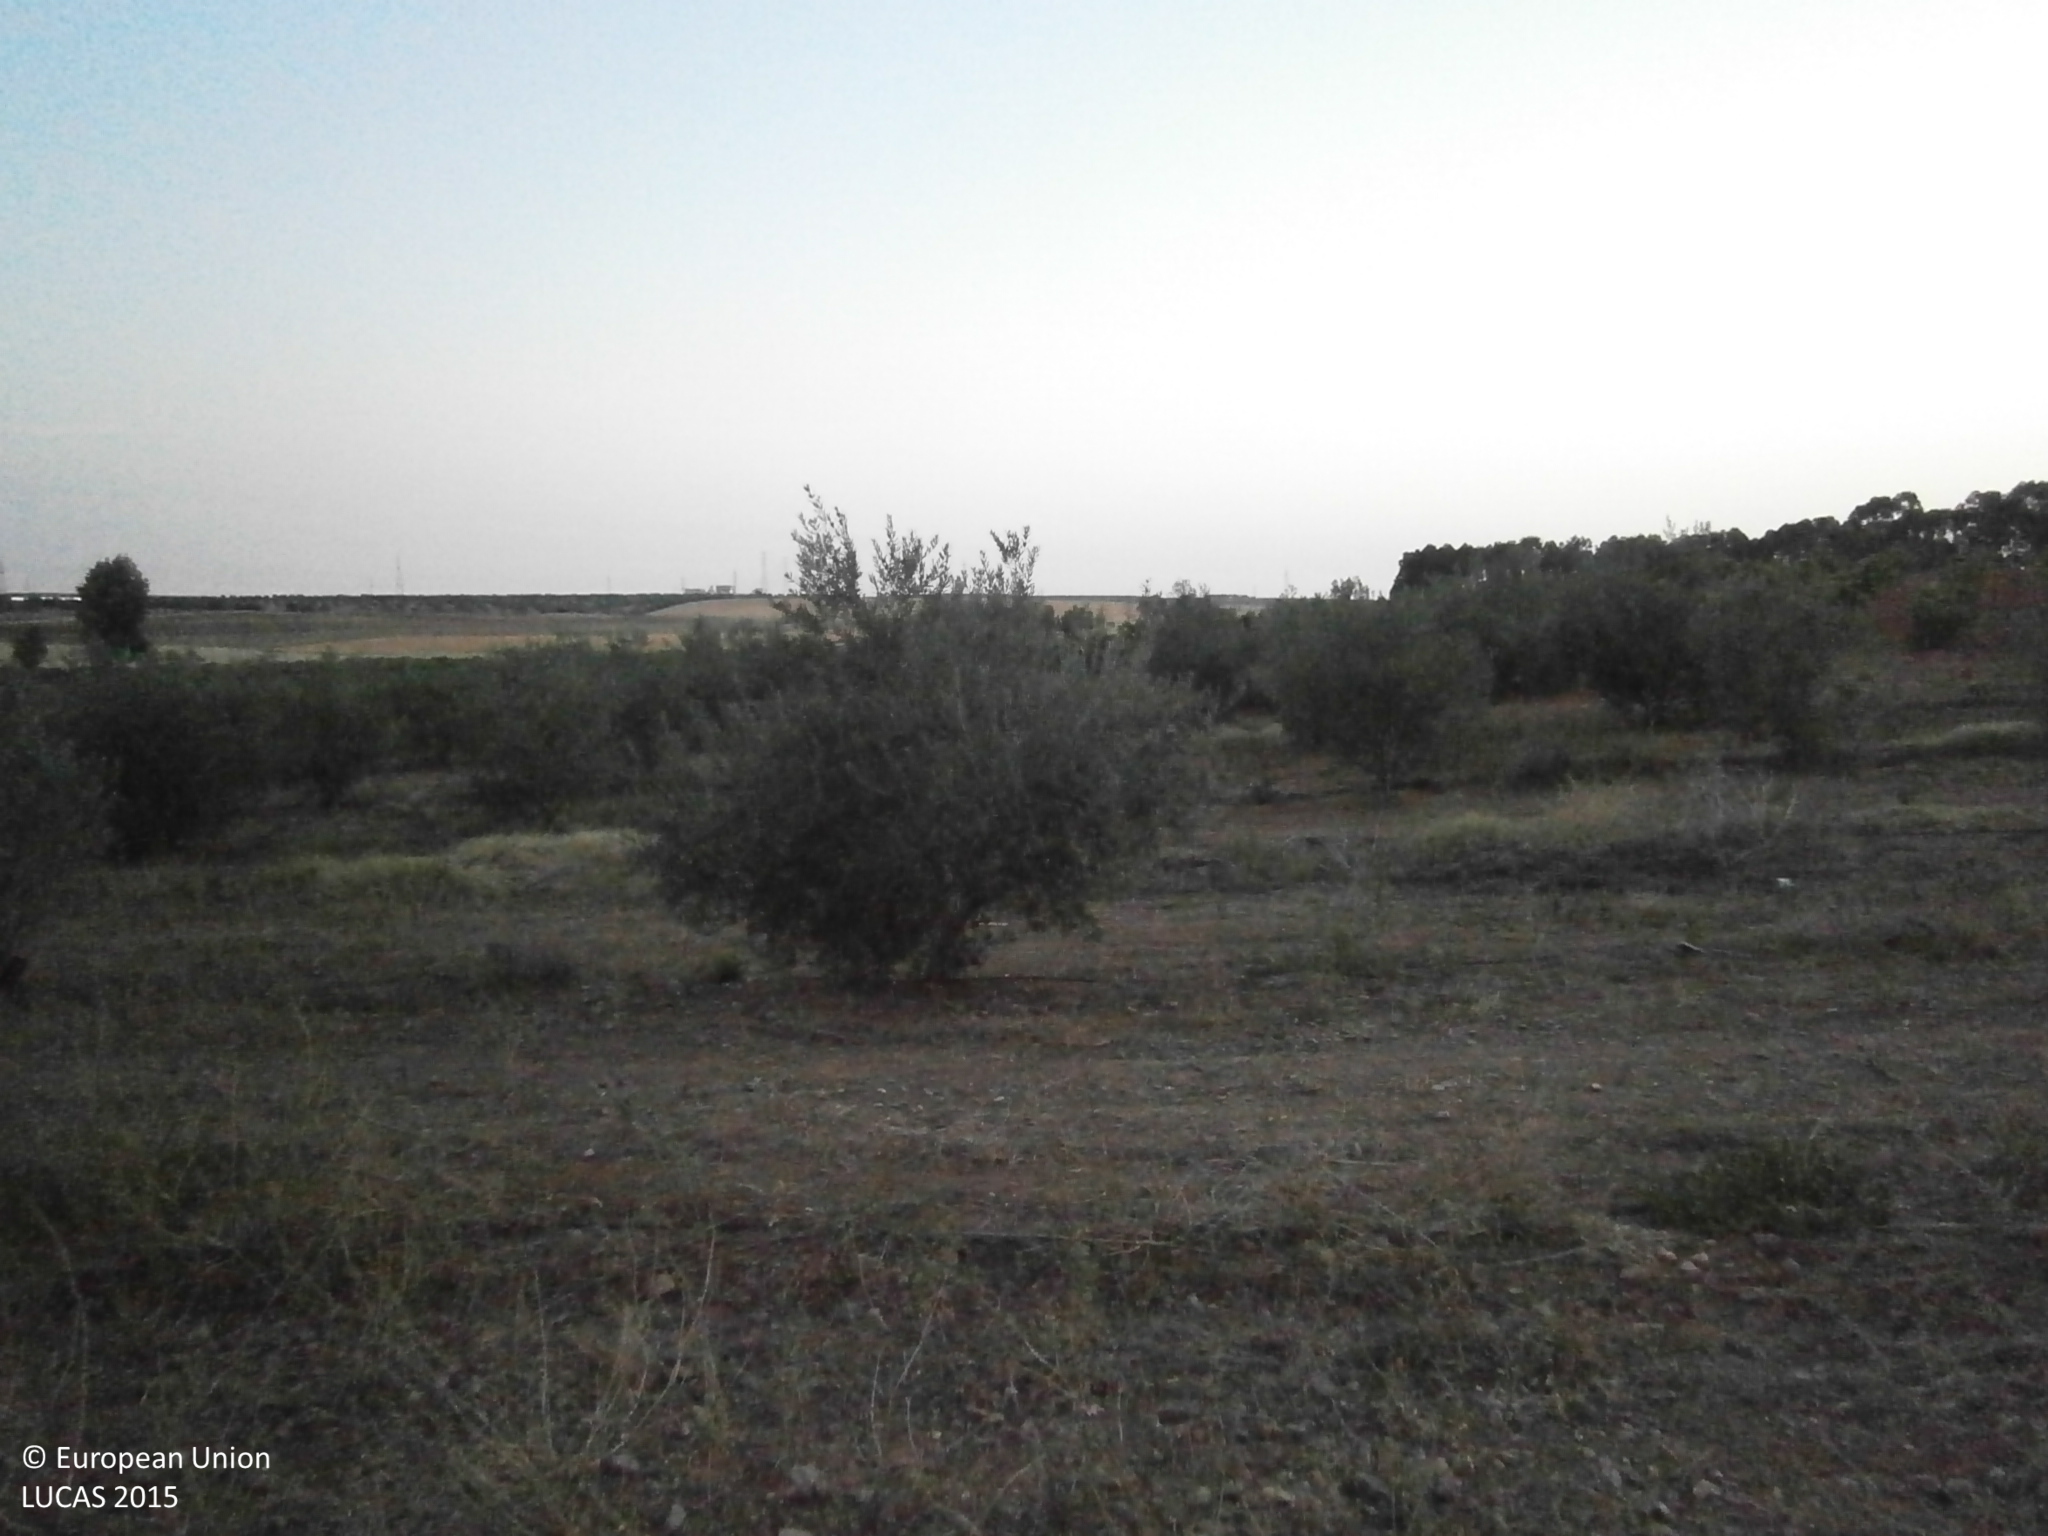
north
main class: Cropland
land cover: Olive groves
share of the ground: 25 - 50 %
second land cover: Spontaneously vegetated surfaces
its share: 25 - 50 %
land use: Agriculture (excluding fallow land and kitchen gardens)
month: July
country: ES
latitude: 38.8035
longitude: -6.8194
